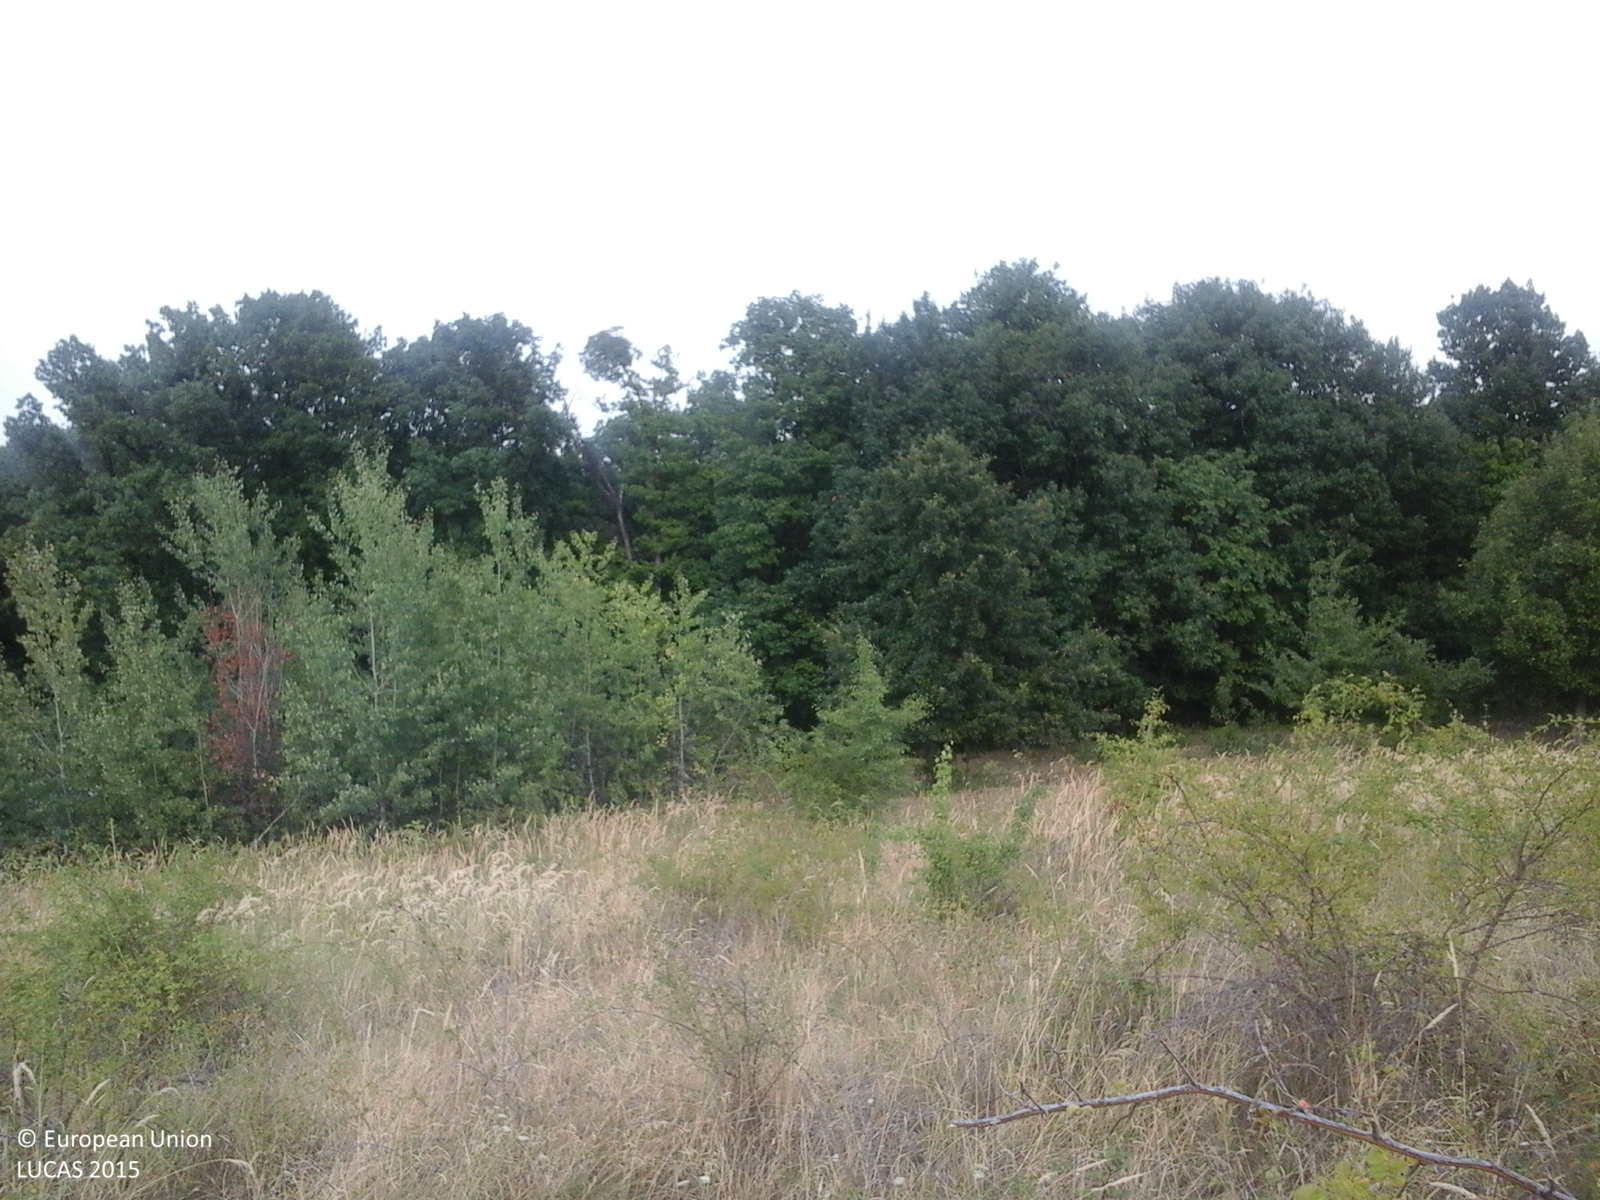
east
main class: Shrubland
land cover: Shrubland with sparse tree cover
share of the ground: > 75 %
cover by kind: herbaceous plants 85 %, shrubs 10 %, broadleaved forest trees 5 %
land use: Semi-natural and natural areas not in use
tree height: < 5 m
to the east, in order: Shrubland with sparse tree cover; Broadleaved woodland
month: August
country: RO
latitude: 44.7671
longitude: 23.5888
